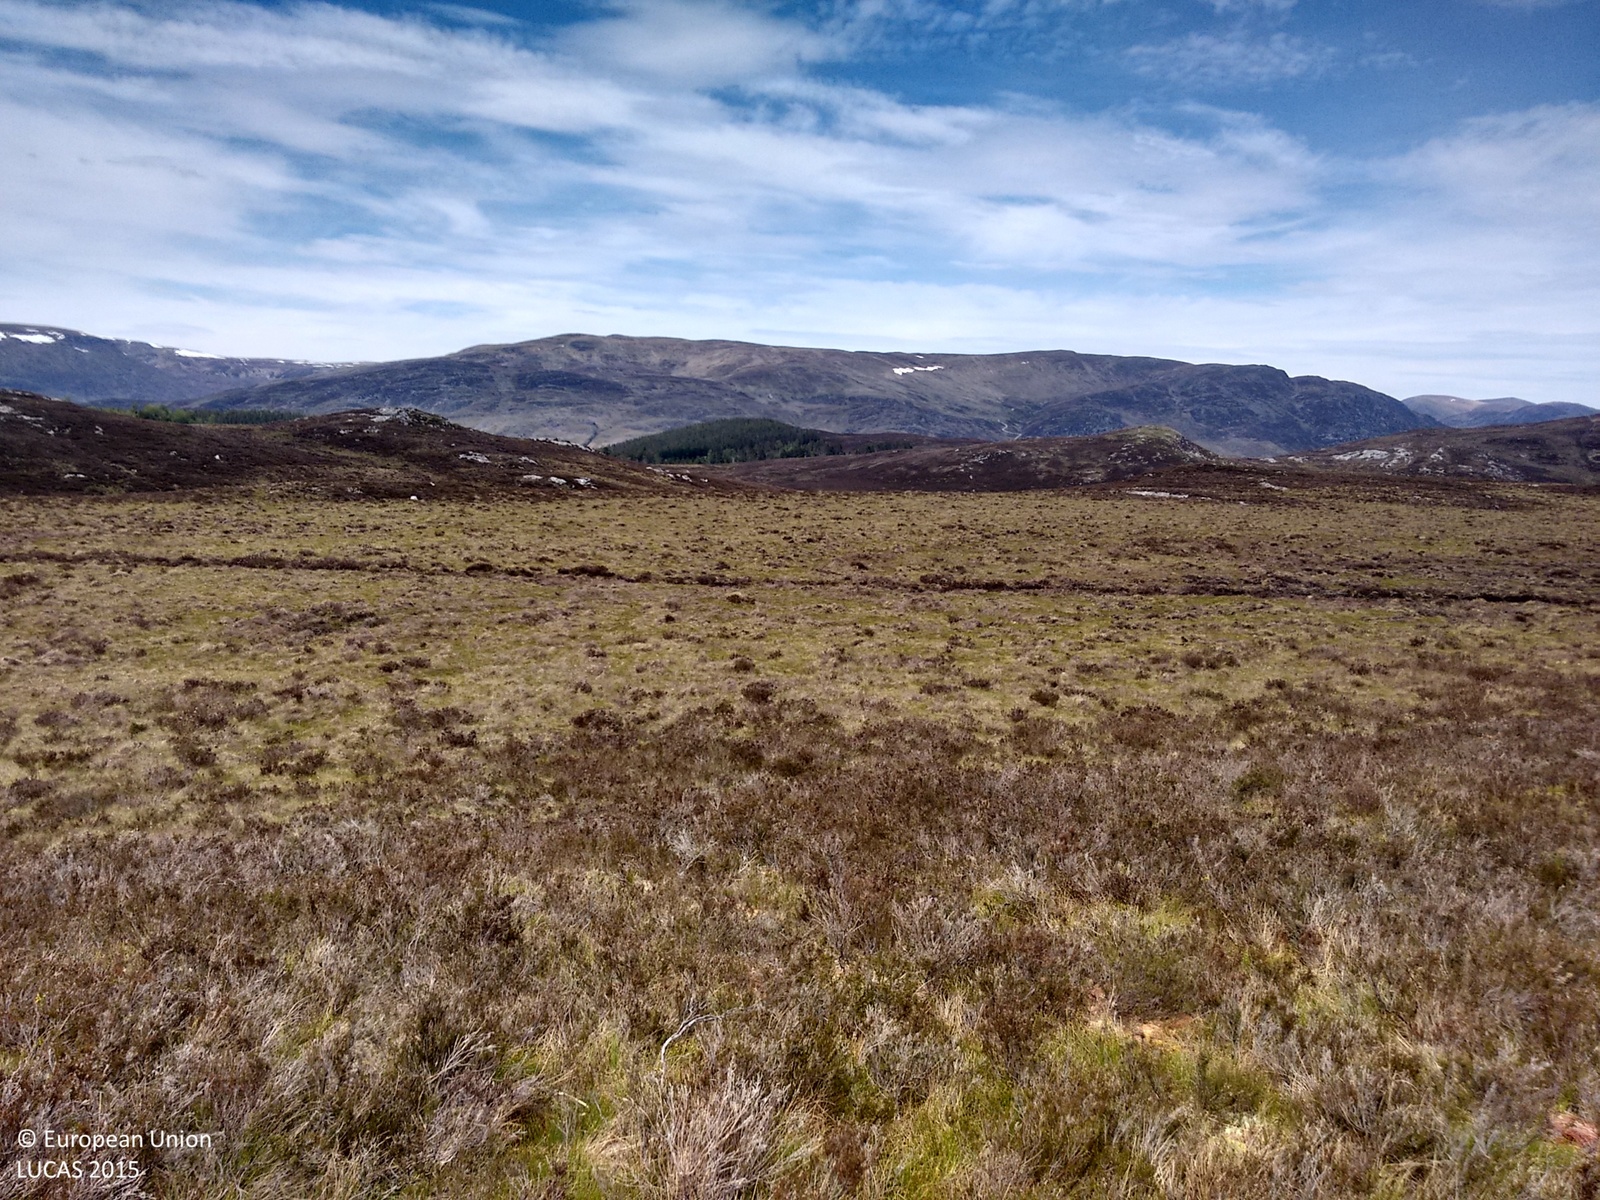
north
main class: Shrubland
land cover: Shrubland without tree cover
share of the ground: > 75 %
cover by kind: shrubs 80 %, herbaceous plants 20 %
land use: Agriculture (excluding fallow land and kitchen gardens)
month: June
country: GB
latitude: 56.9921
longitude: -4.2934
